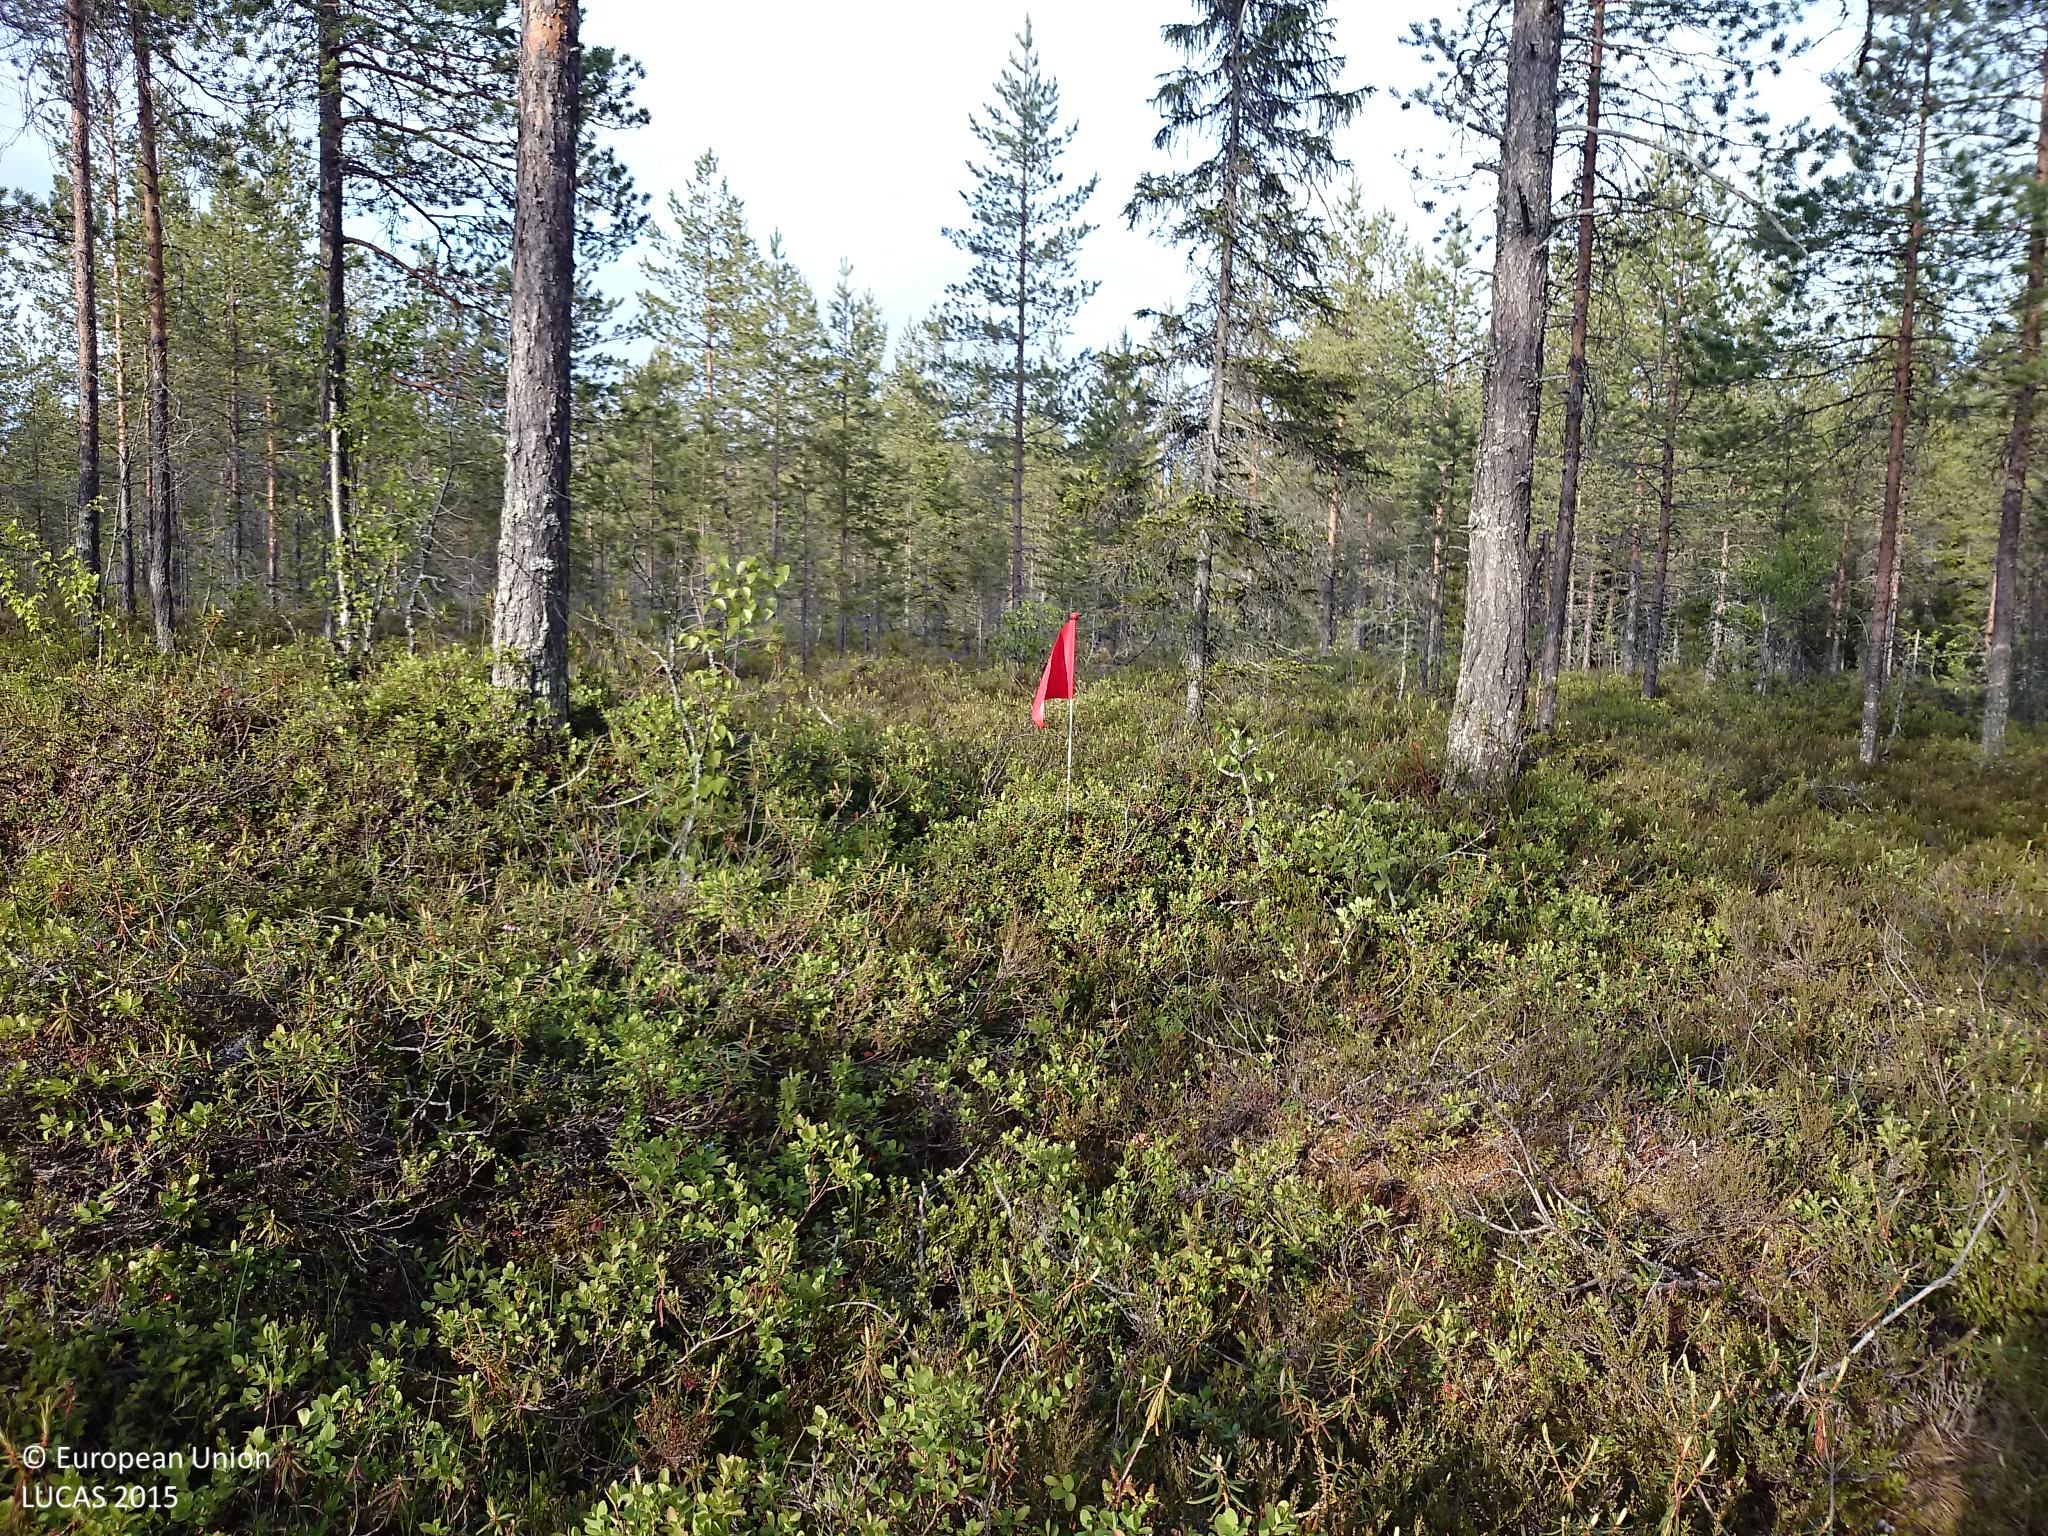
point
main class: Woodland
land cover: Pine dominated coniferous woodland
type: boreal forest
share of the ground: 50 - 75 %
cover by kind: coniferous forest trees 60 %, shrubs 40 %
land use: Forestry
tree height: > 5 m
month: June
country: SE
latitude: 64.0596
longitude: 20.6163
